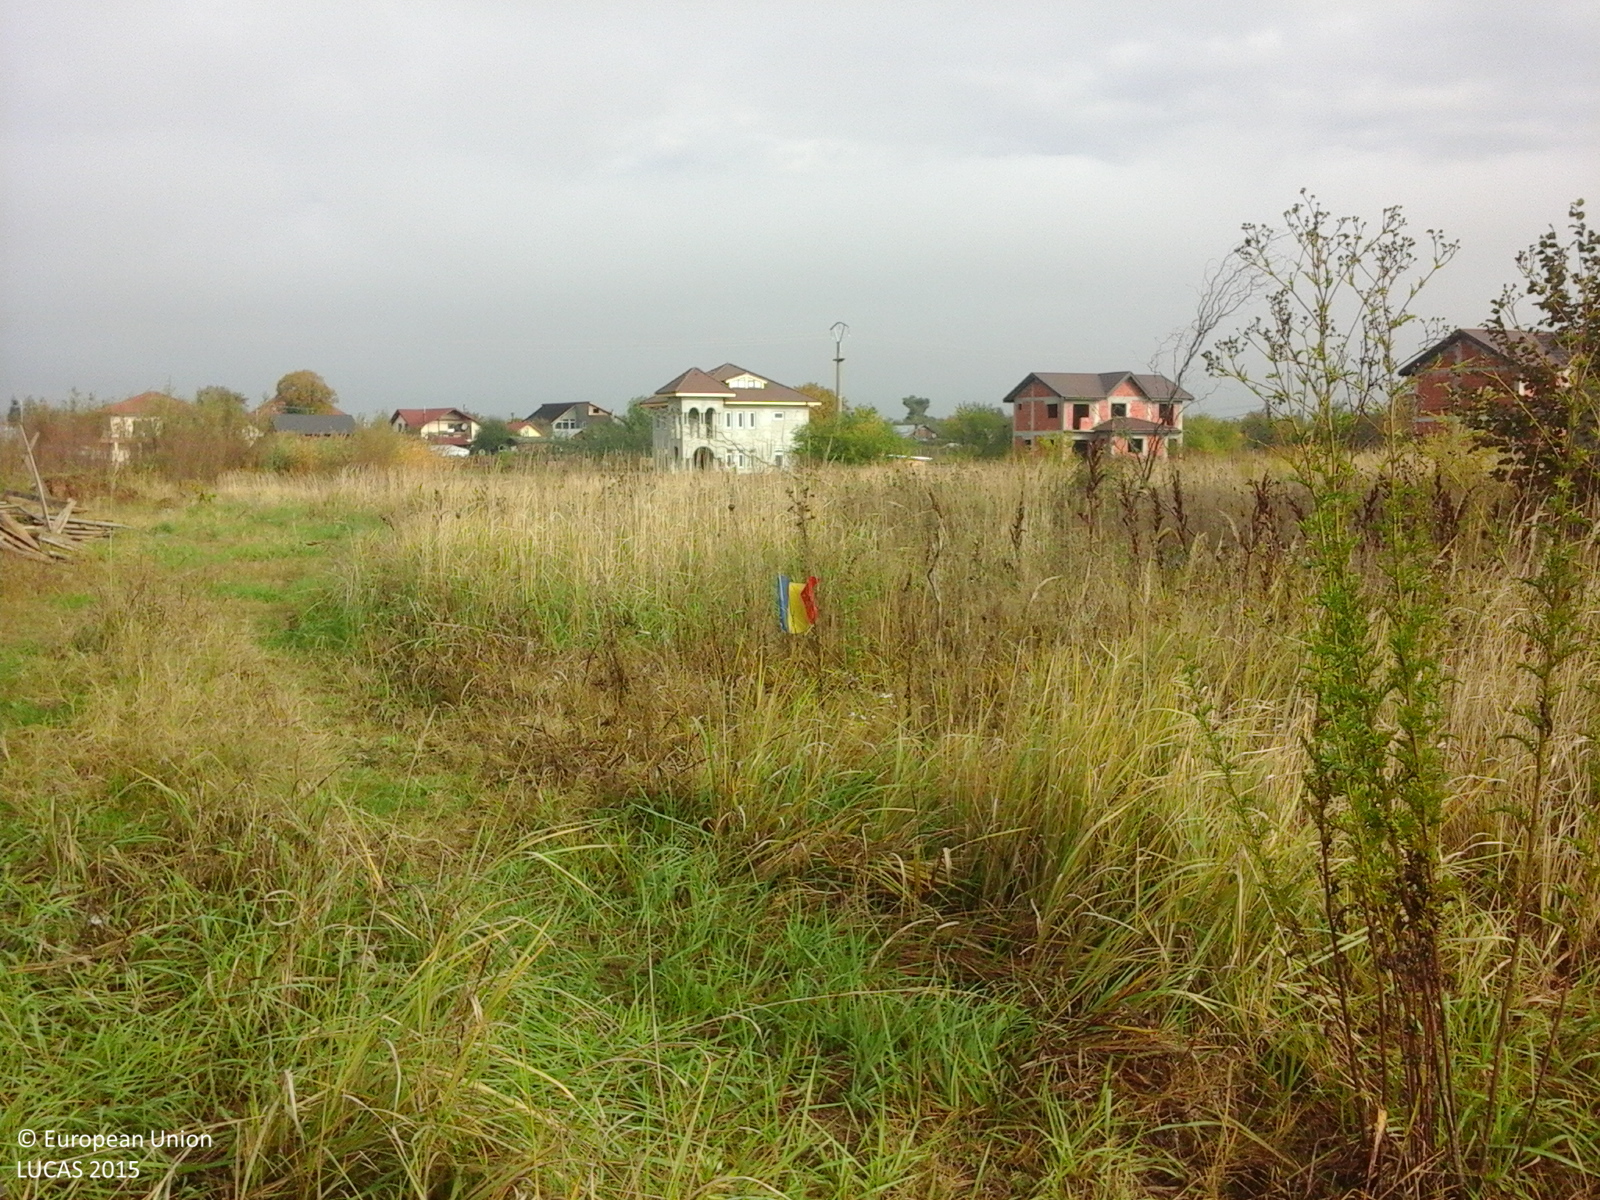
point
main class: Grassland
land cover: Spontaneously vegetated surfaces
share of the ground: > 75 %
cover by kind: herbaceous plants 100 %
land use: Fallow land
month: October
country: RO
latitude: 44.6782
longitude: 26.1169
